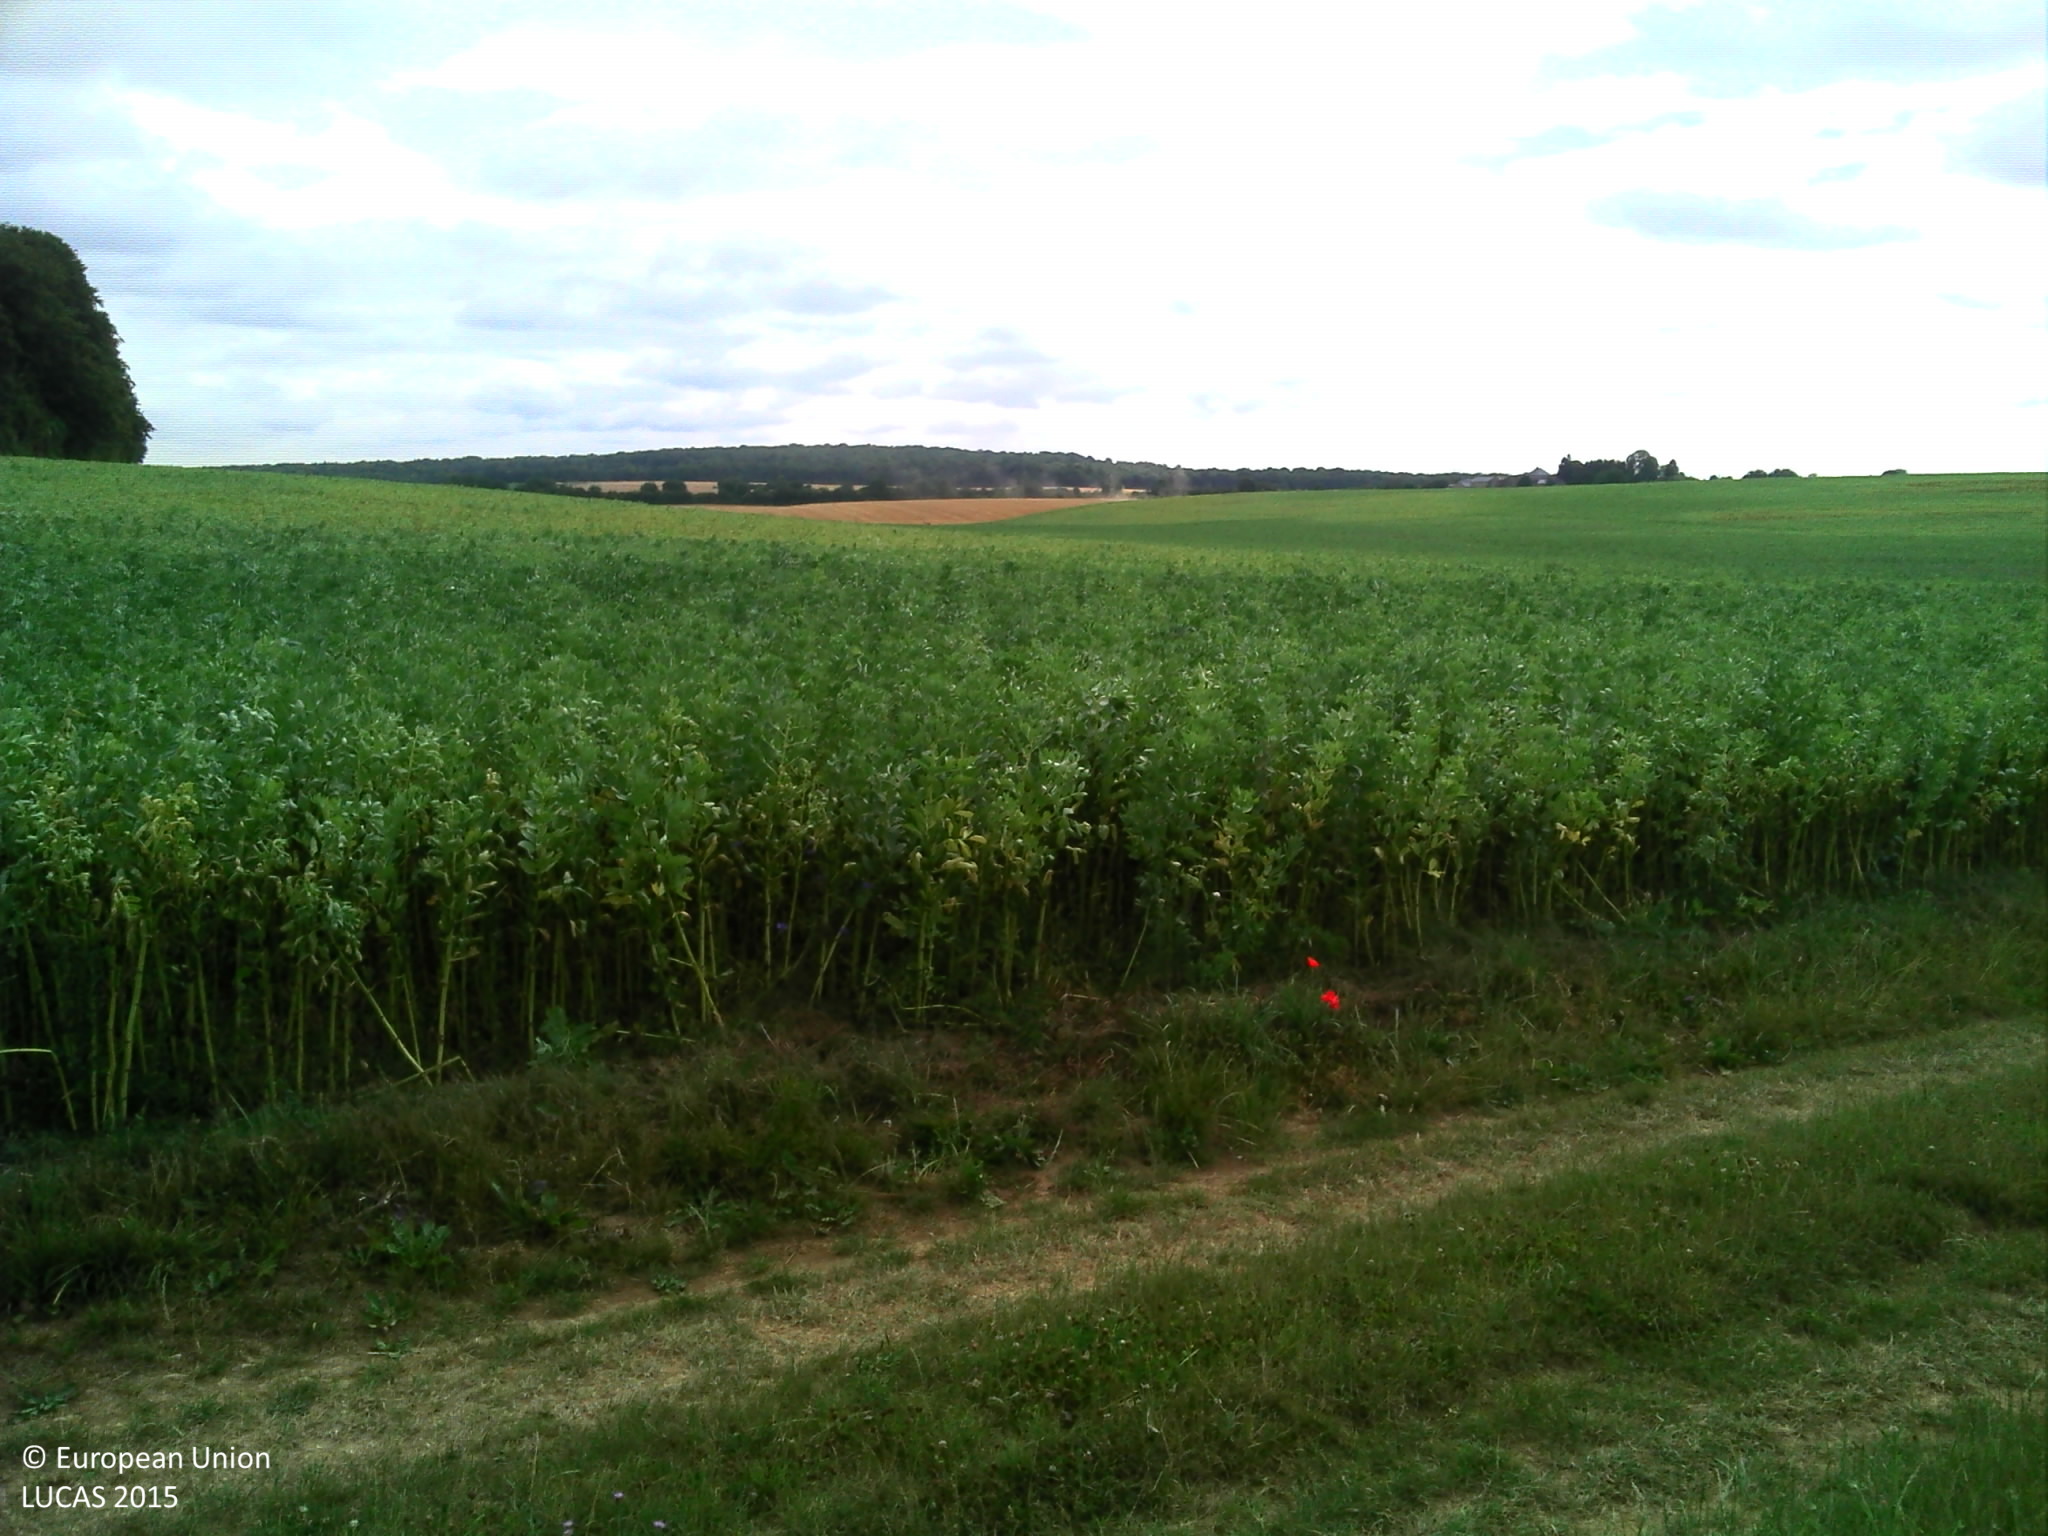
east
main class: Cropland
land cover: Rape and turnip rape
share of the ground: > 75 %
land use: Agriculture (excluding fallow land and kitchen gardens)
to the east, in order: Rape and turnip rape; Grass margins; Tracks; Grass margins; Dry pulses
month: July
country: FR
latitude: 49.4454
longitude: 5.9304
